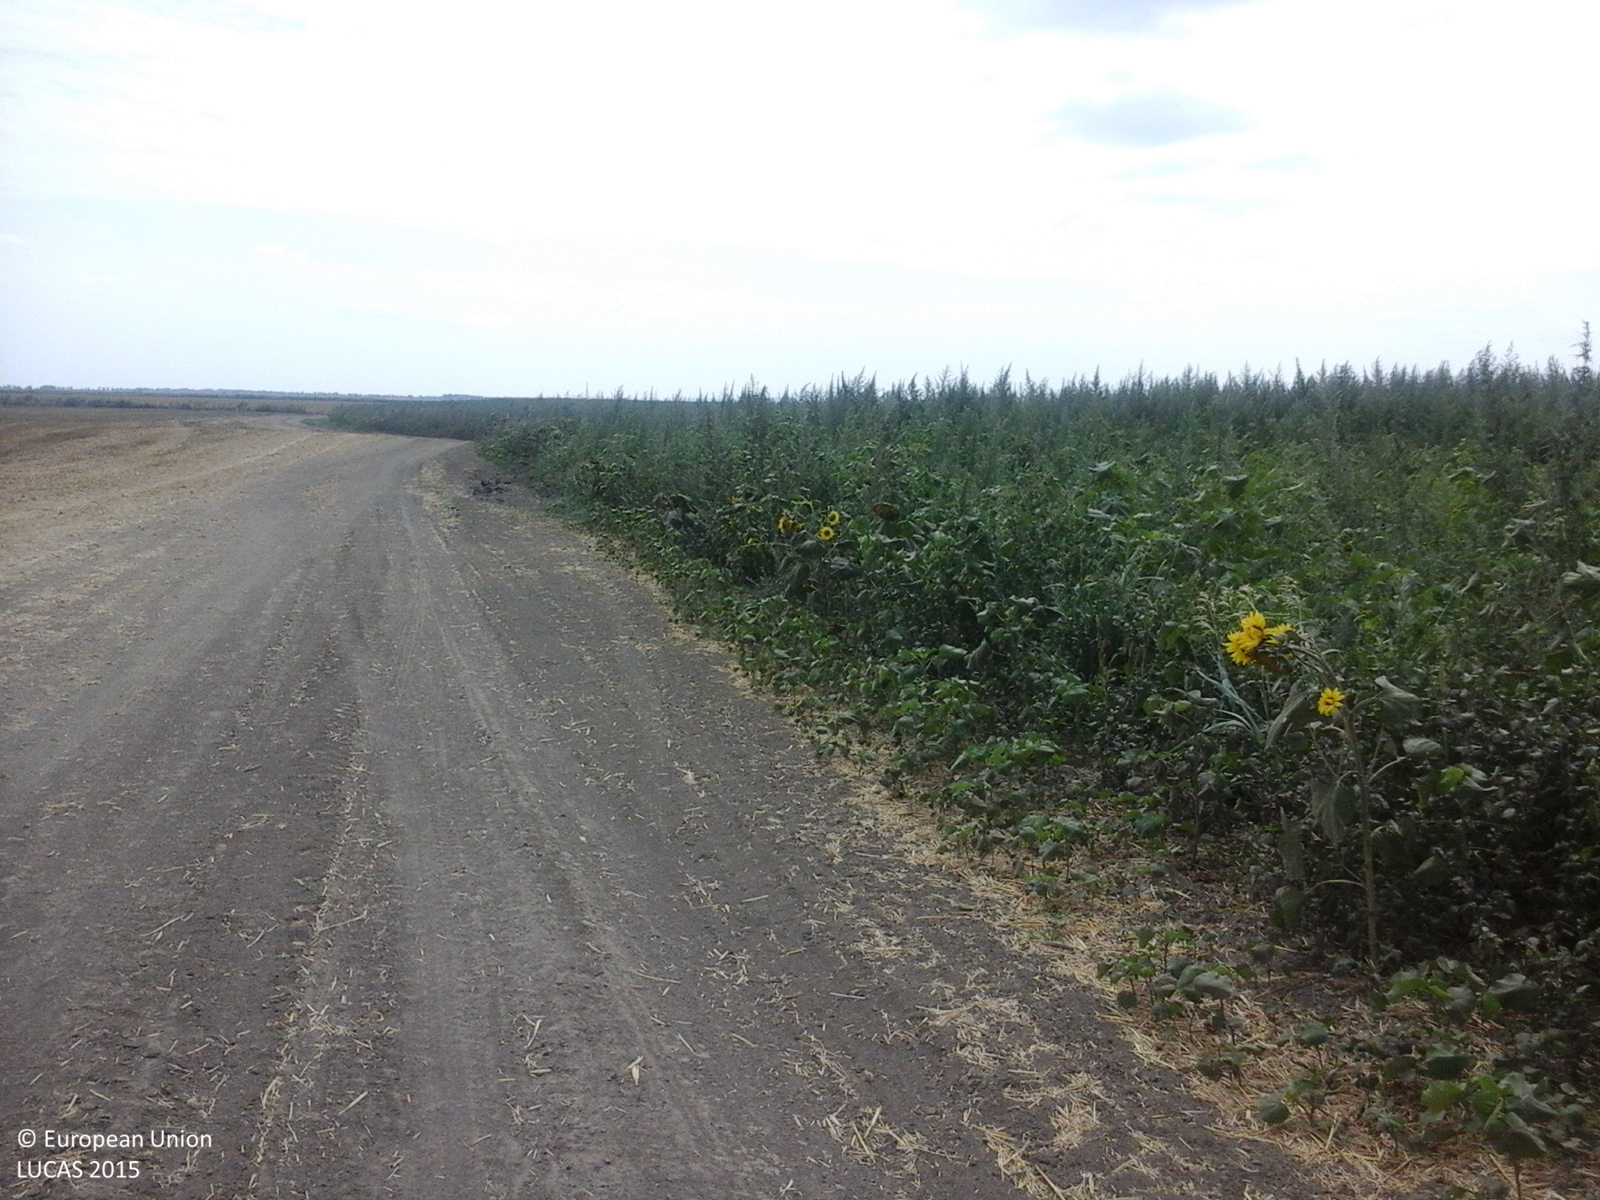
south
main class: Cropland
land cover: Sunflower
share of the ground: 50 - 75 %
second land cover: Spontaneously vegetated surfaces
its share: 25 - 50 %
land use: Agriculture (excluding fallow land and kitchen gardens)
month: August
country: RO
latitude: 45.3126
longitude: 29.0944
